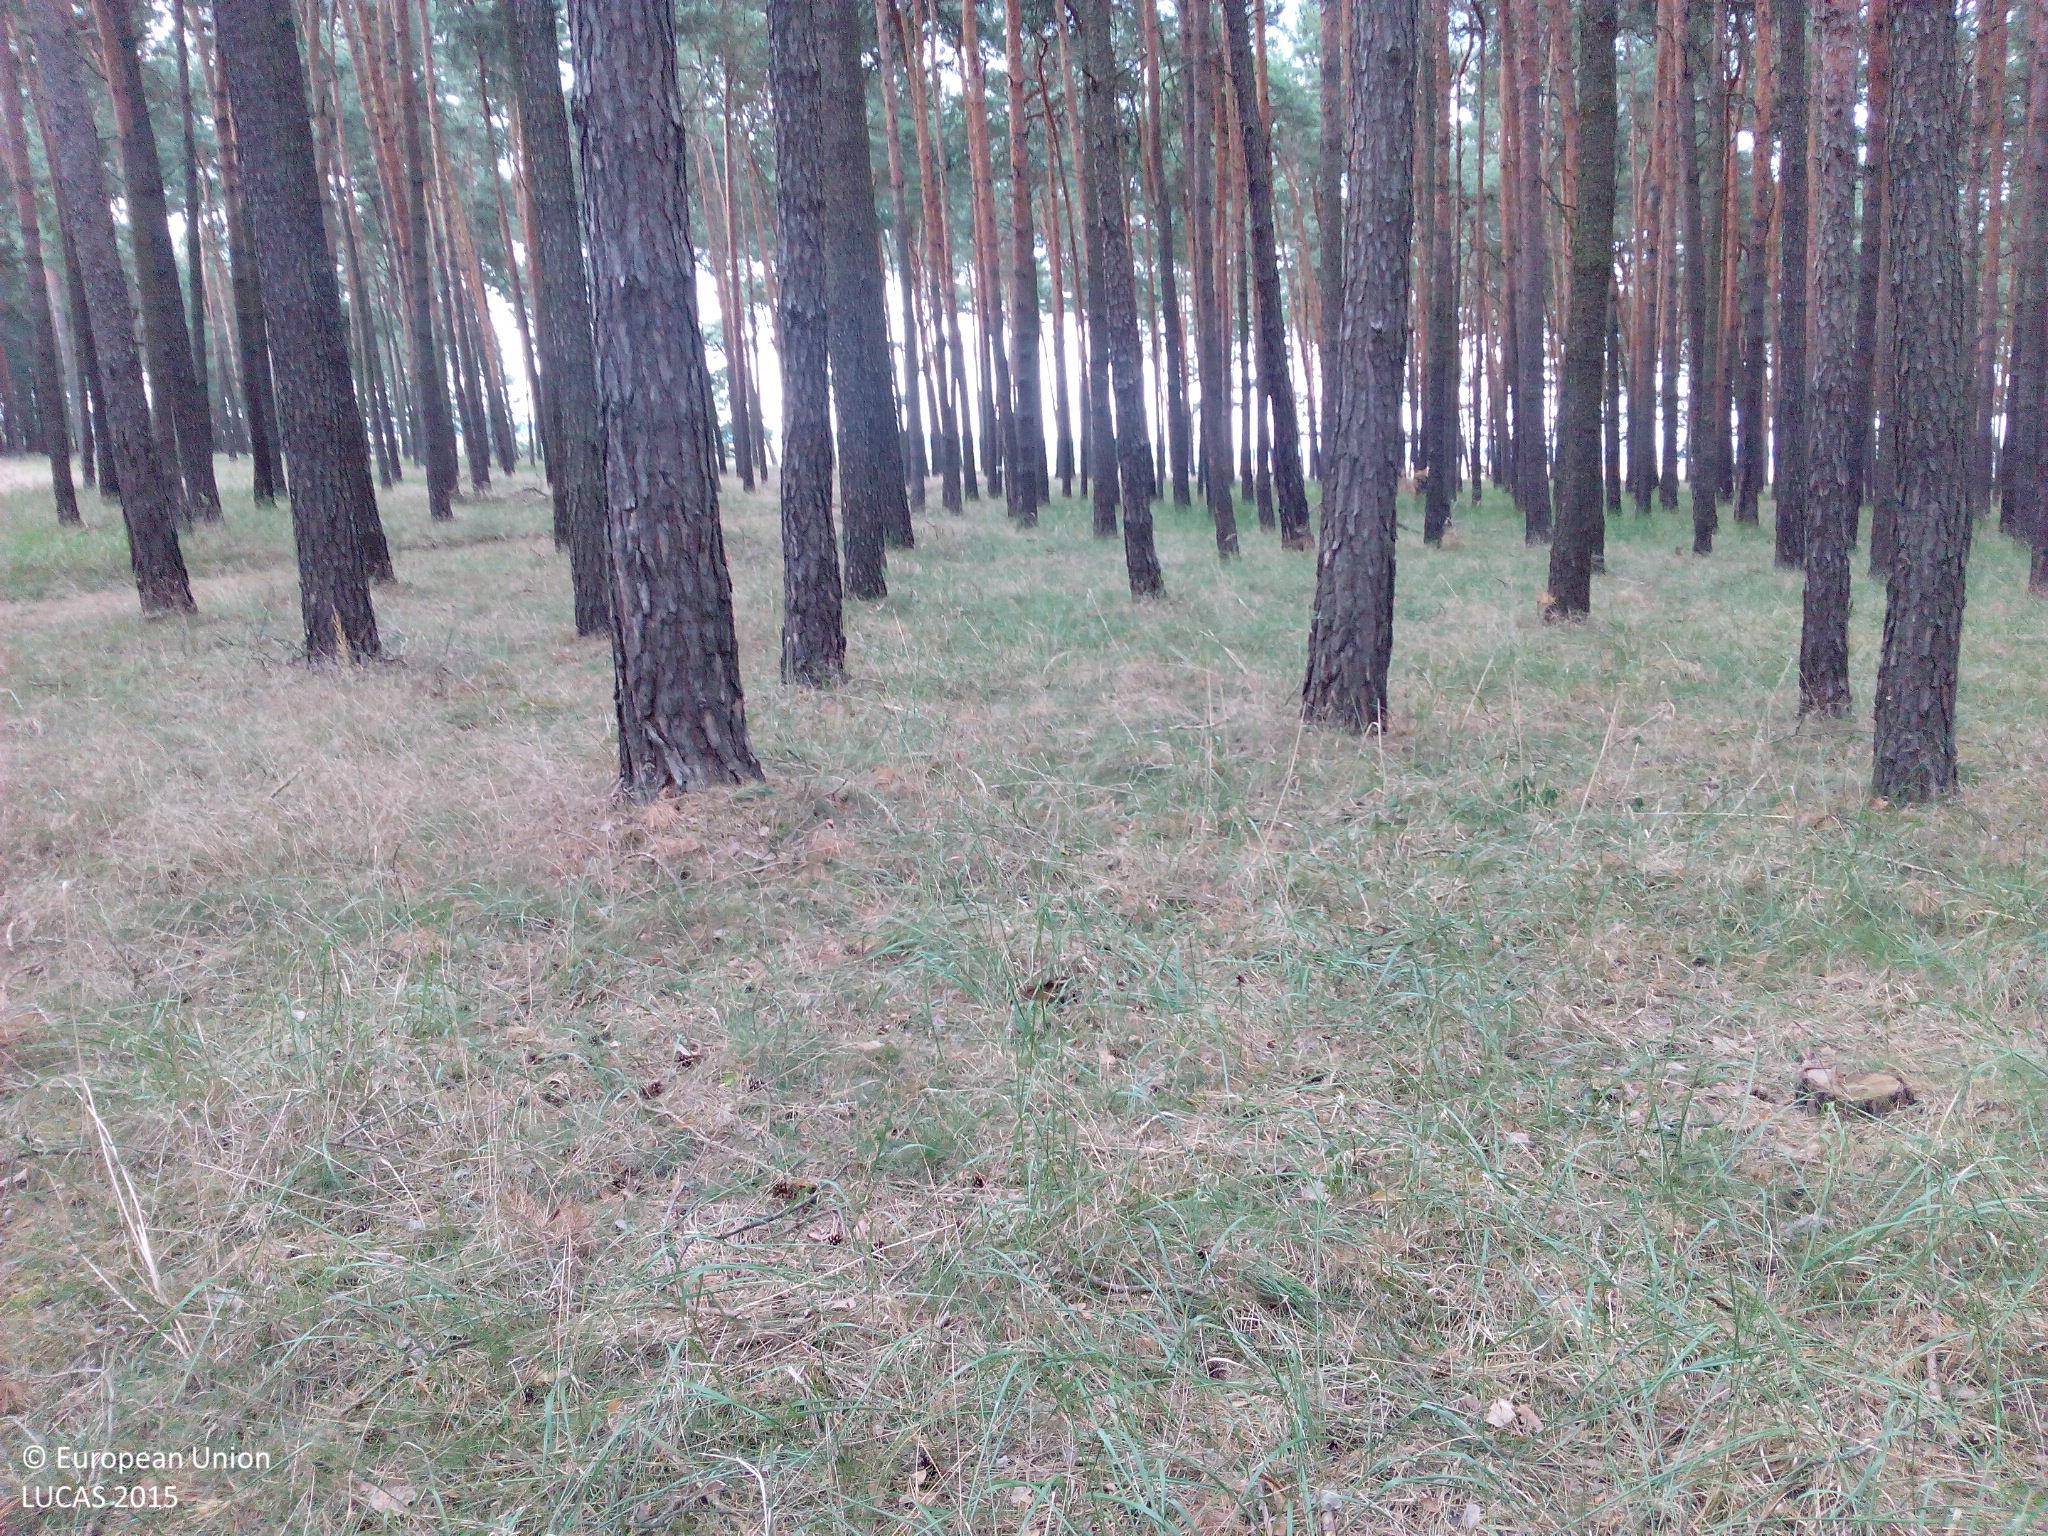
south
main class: Woodland
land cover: Pine dominated coniferous woodland
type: hemiboreal forest and nemoral coniferous forest and mixed broadleaved-coniferous forest
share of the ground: > 75 %
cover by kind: coniferous forest trees 85 %, unconsolidated bare surface 10 %, herbaceous plants 5 %
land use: Forestry
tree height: > 5 m
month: August
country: DE
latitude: 51.8687
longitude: 13.1225
